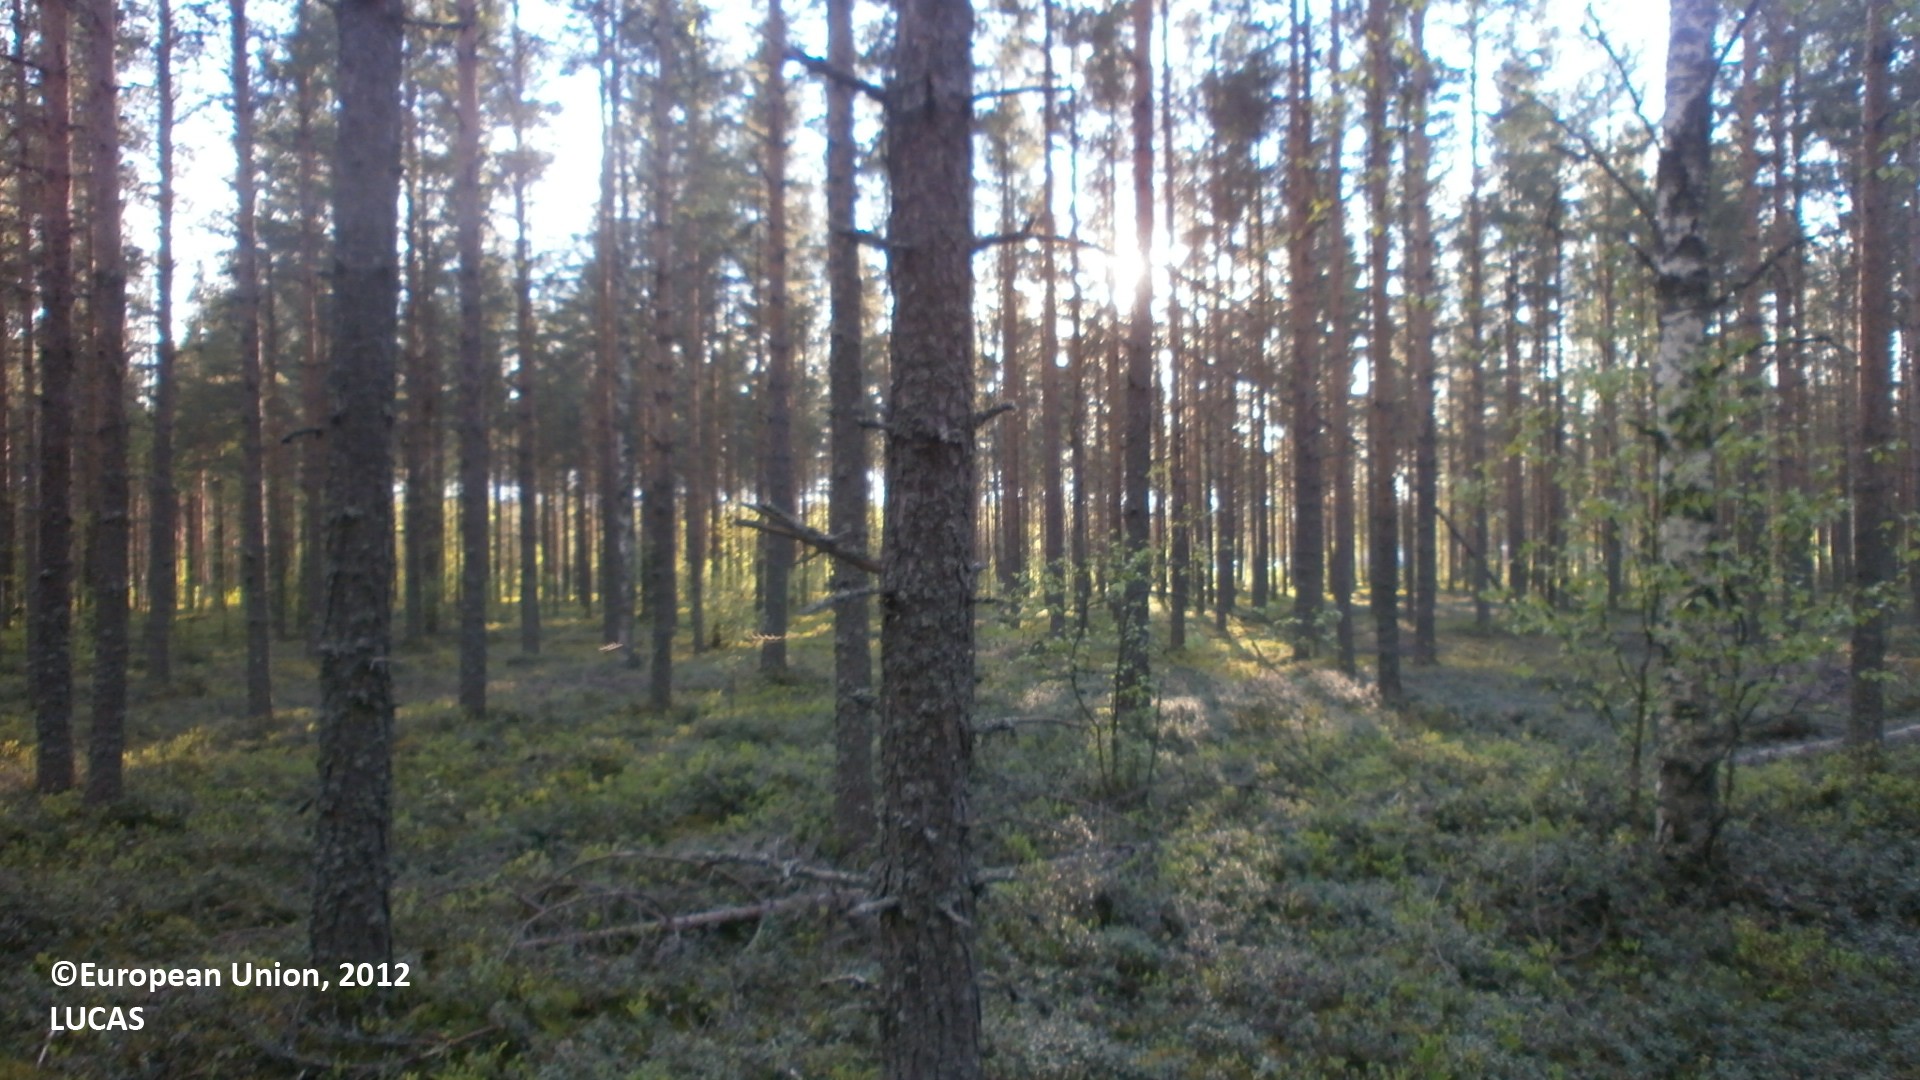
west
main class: Woodland
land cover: Pine dominated coniferous woodland
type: hemiboreal forest and nemoral coniferous forest and mixed broadleaved-coniferous forest
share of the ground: 50 - 75 %
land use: Semi-natural and natural areas not in use
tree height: > 5 m
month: June
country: FI
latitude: 64.4915
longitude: 25.0014
